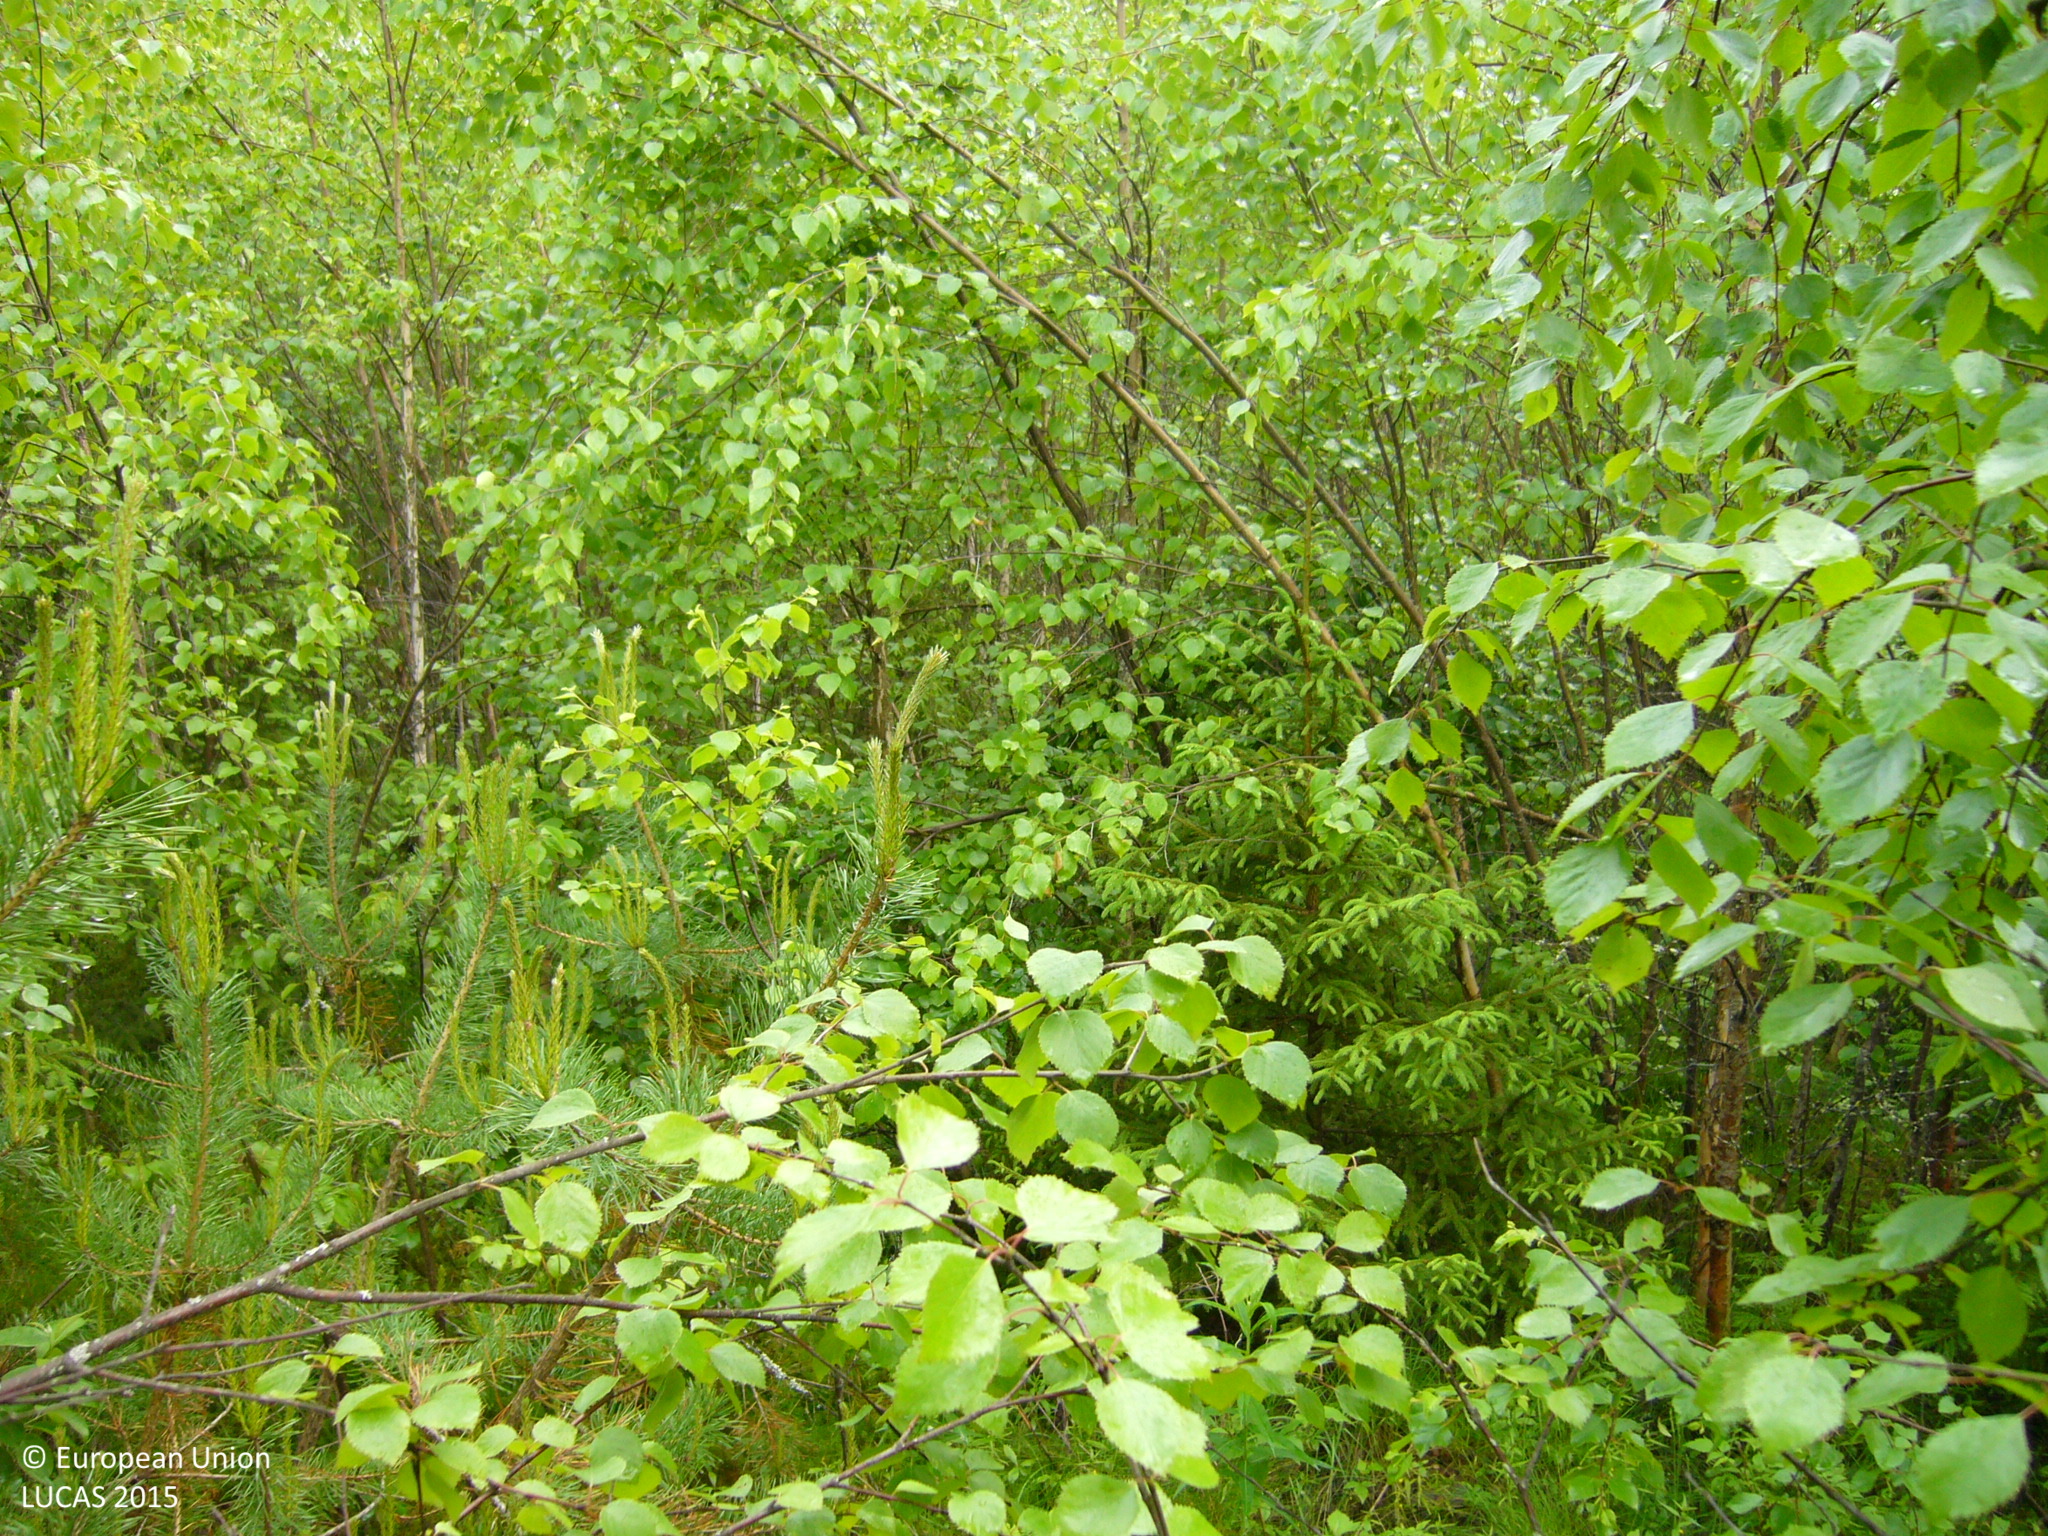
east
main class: Woodland
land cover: Other mixed woodland
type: boreal forest
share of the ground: > 75 %
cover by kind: broadleaved forest trees 70 %, coniferous forest trees 25 %, shrubs 5 %
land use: Forestry
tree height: < 5 m
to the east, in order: Other mixed woodland; Pine dominated mixed woodland; Ditches and canals; Pine dominated mixed woodland
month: June
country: FI
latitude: 63.6850
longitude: 26.5640
